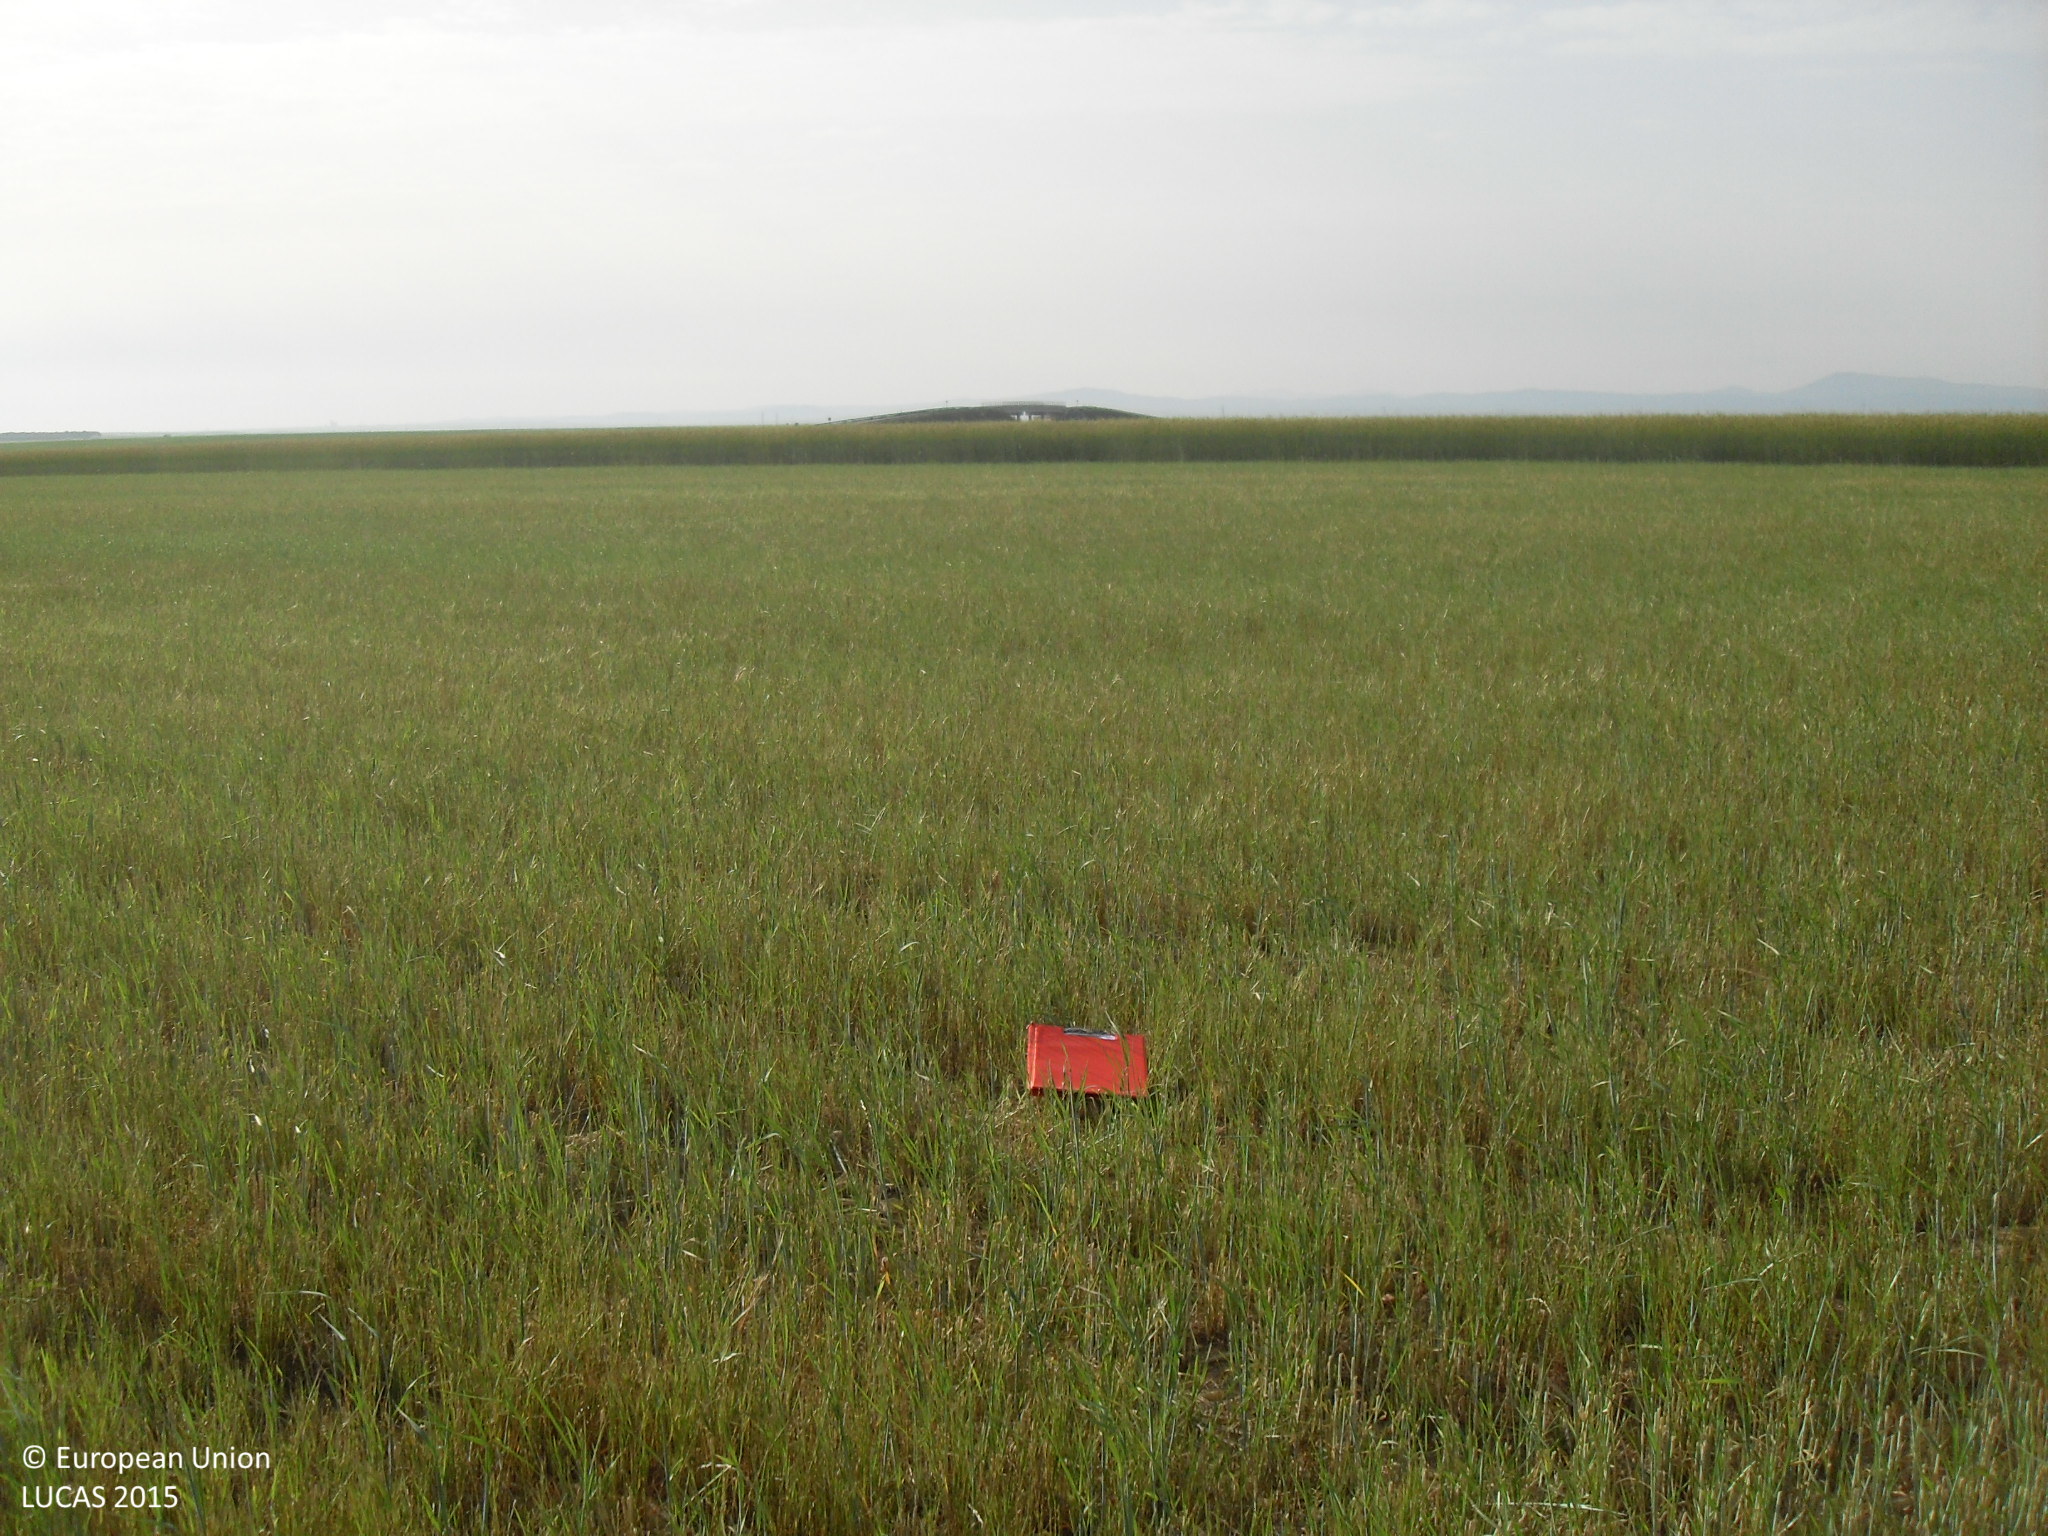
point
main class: Cropland
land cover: Mixed cereals for fodder
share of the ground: > 75 %
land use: Agriculture (excluding fallow land and kitchen gardens)
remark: Harvested field
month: May
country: ES
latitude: 40.9599
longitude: -5.3626
